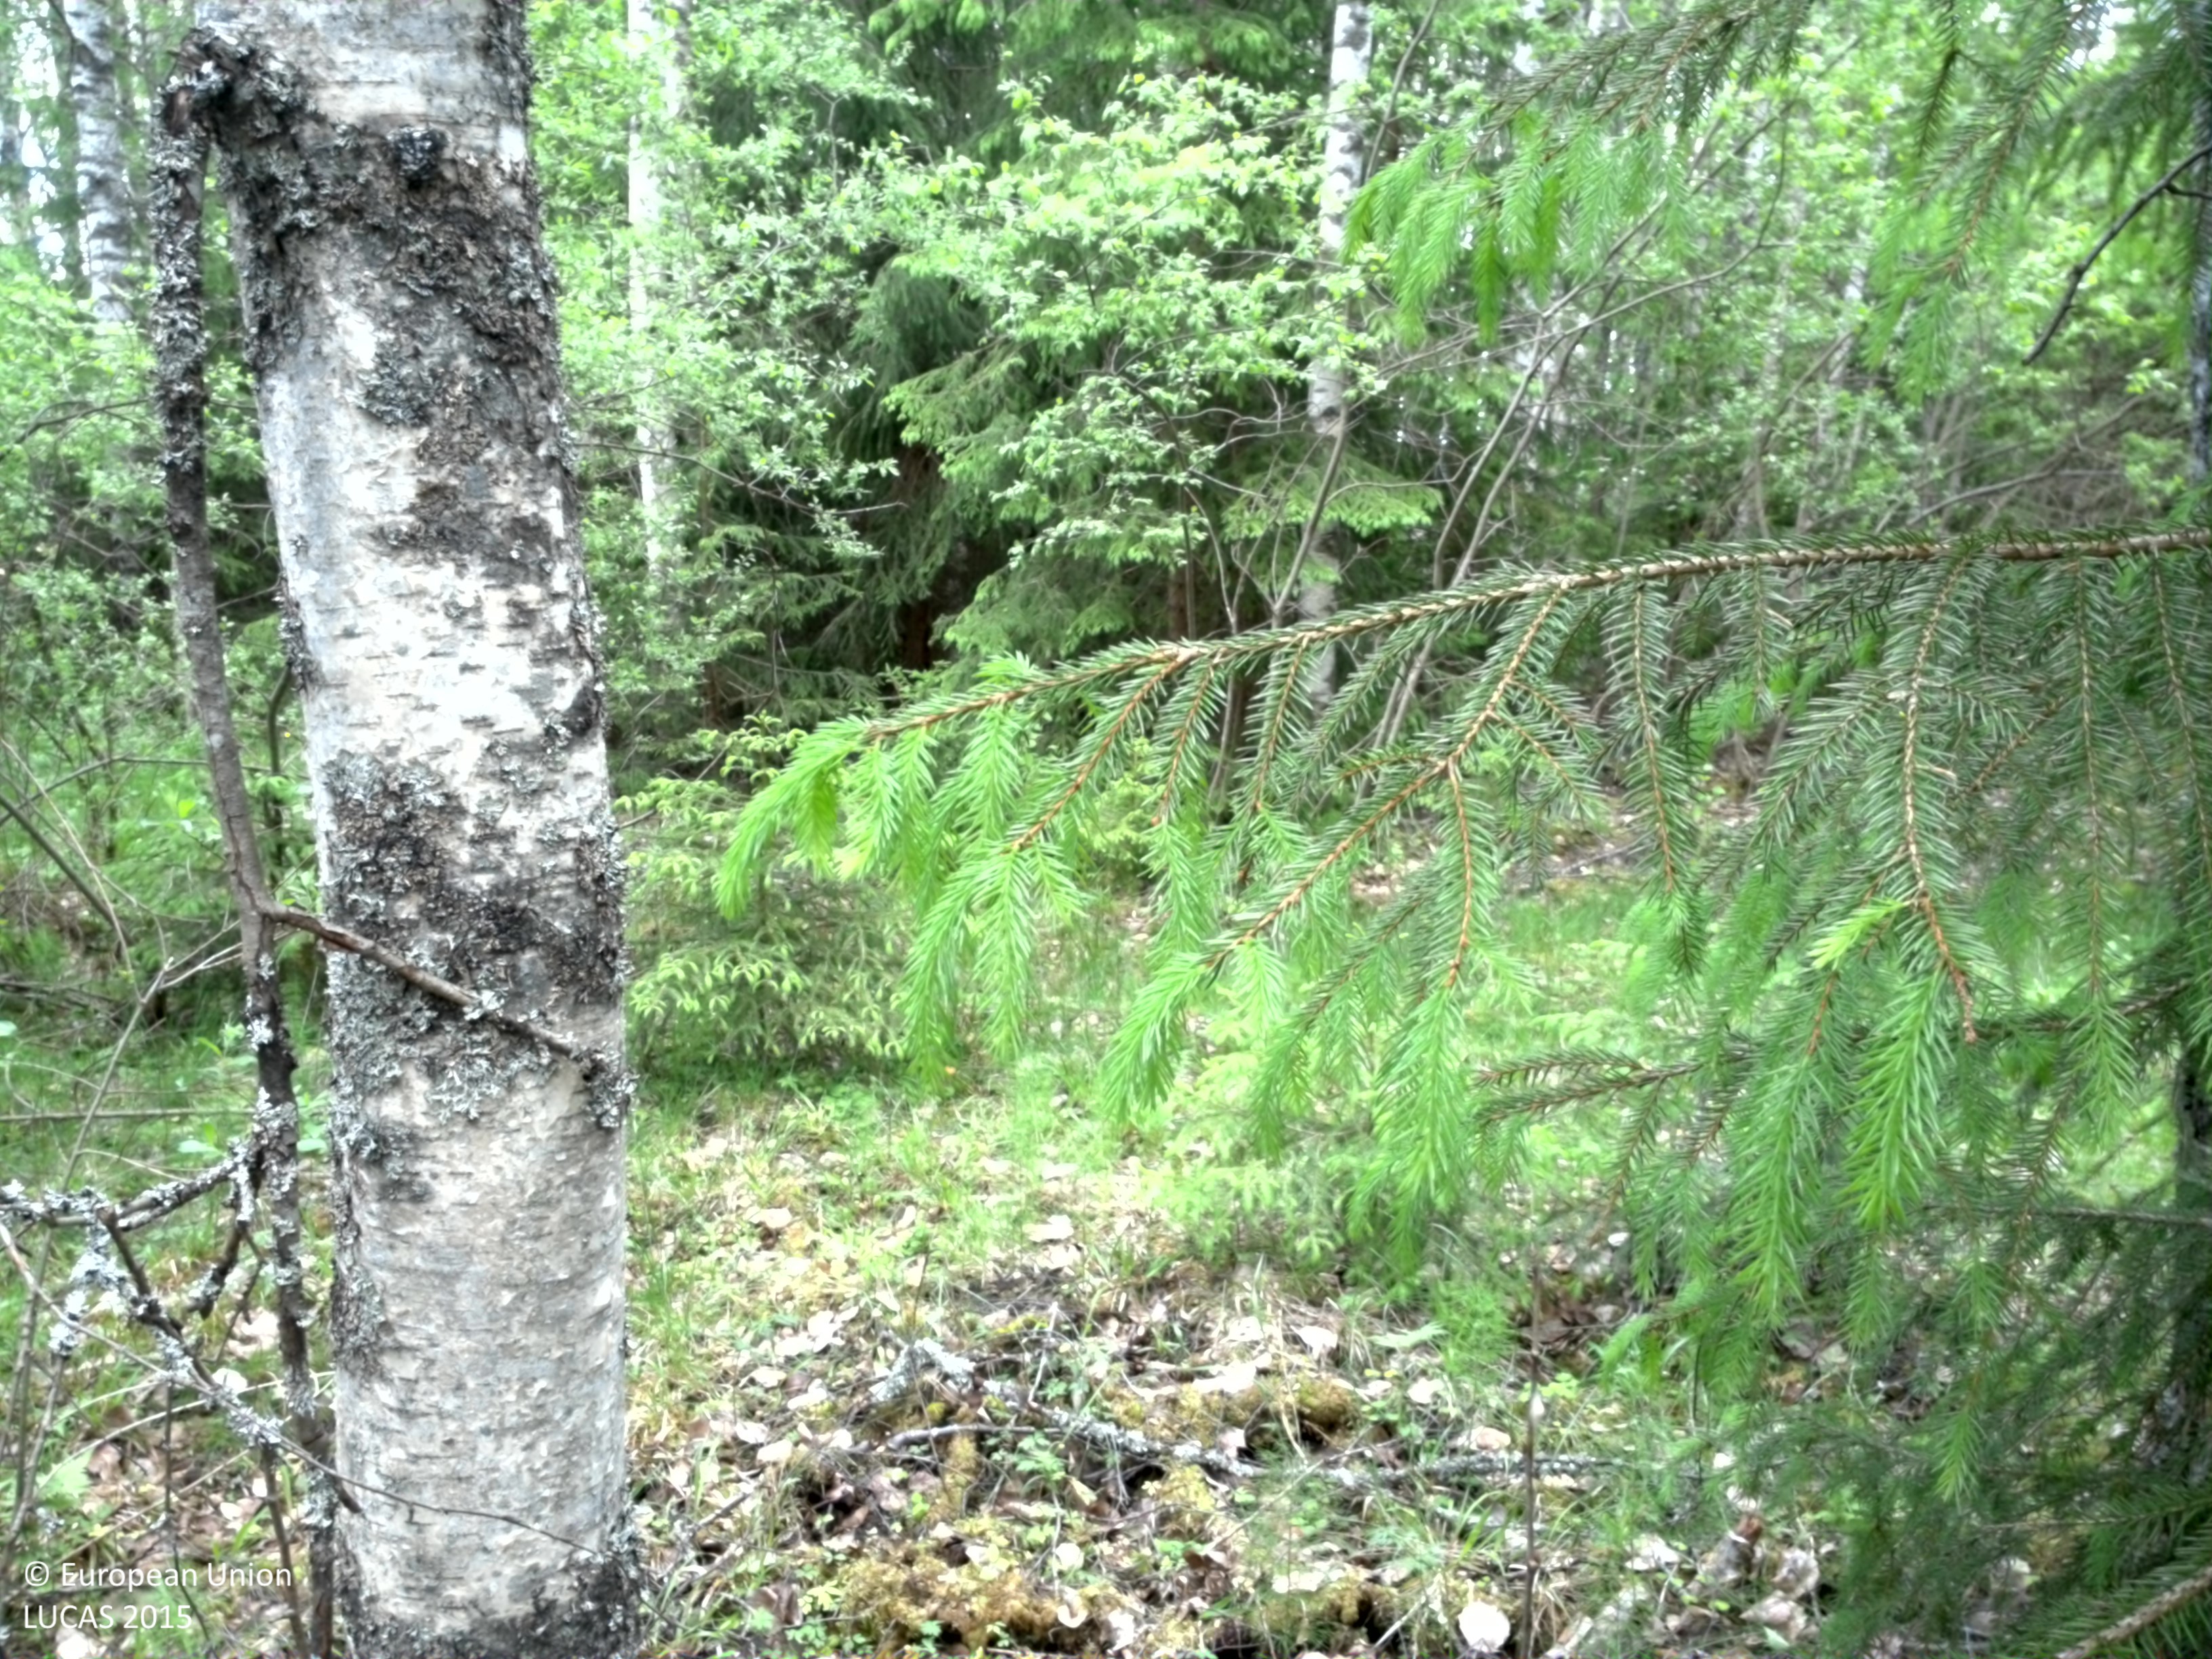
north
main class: Woodland
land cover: Spruce dominated mixed woodland
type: boreal forest
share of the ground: 50 - 75 %
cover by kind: broadleaved forest trees 50 %, coniferous forest trees 20 %, shrubs 15 %, herbaceous plants 15 %
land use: Forestry
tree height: > 5 m
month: June
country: SE
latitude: 59.5239
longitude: 14.1805
